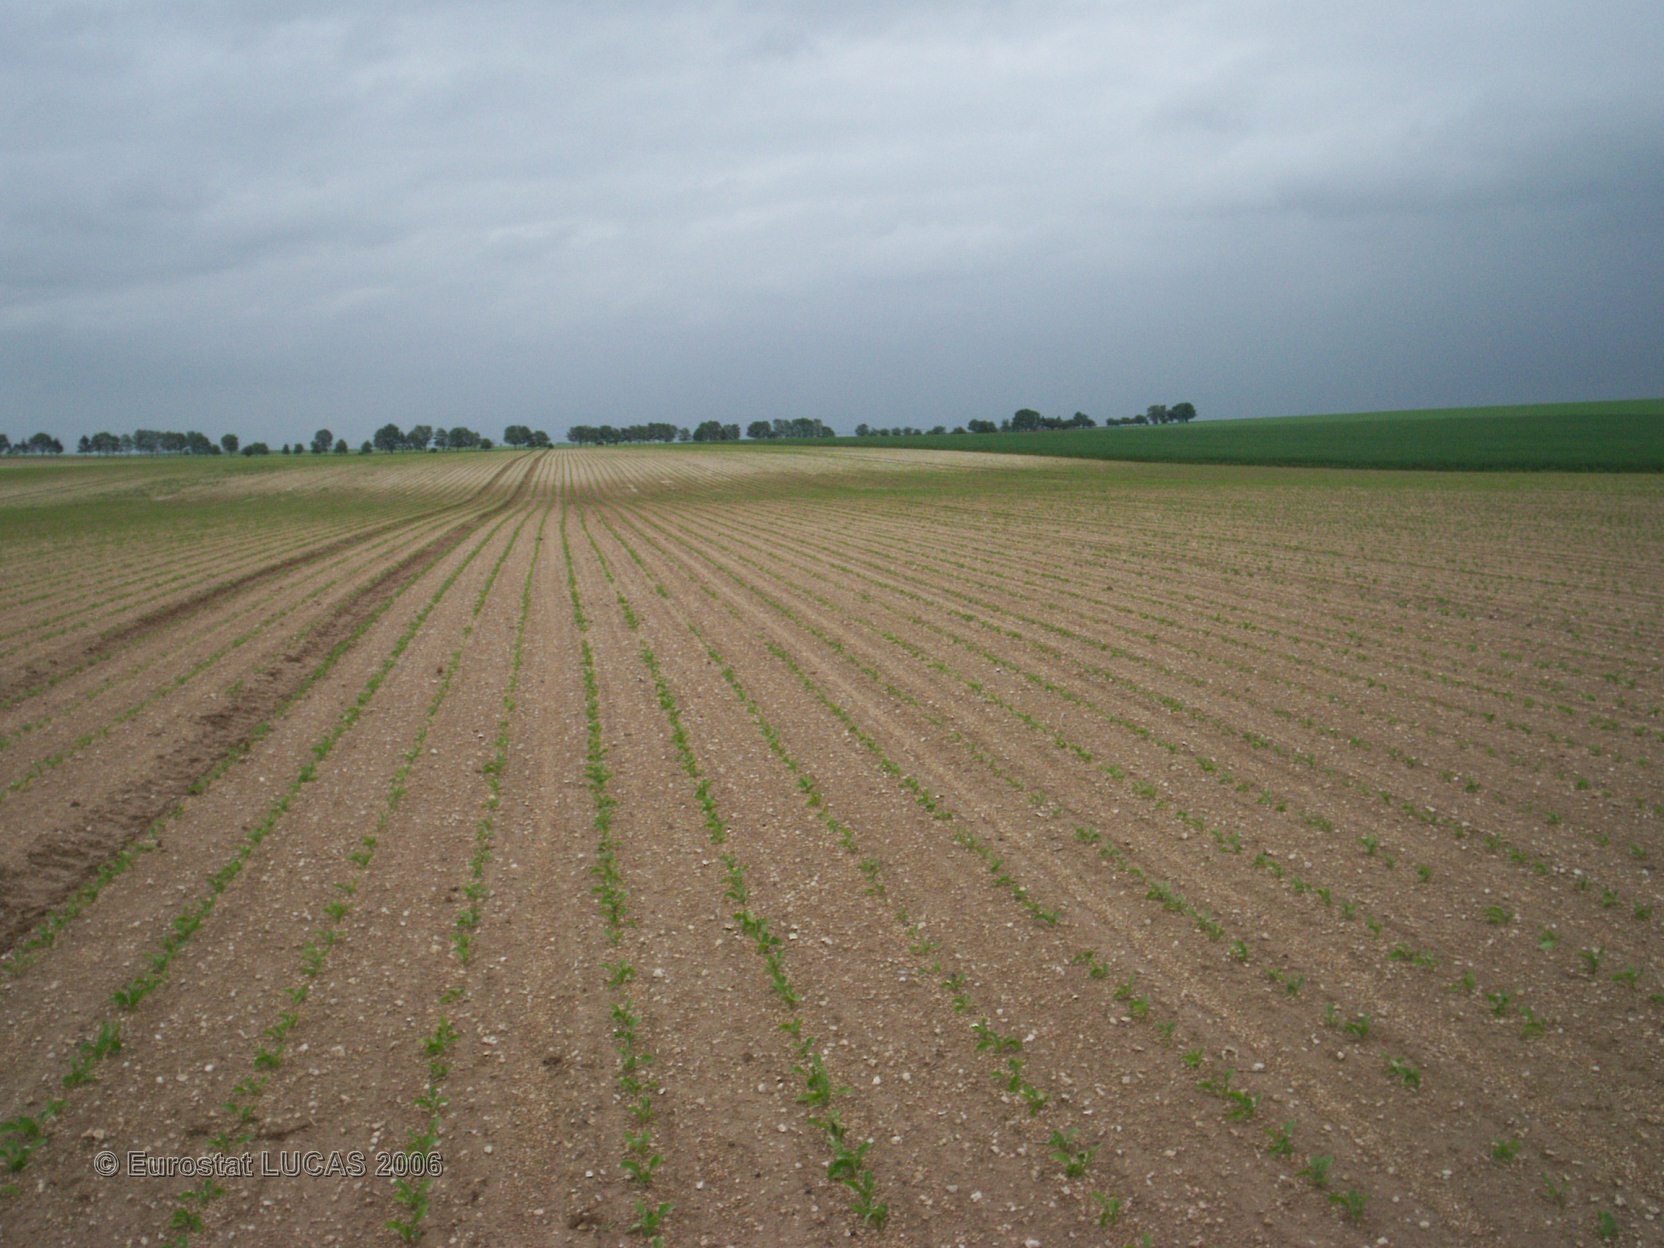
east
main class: Cropland
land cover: Sugar beet
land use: Agriculture (excluding fallow land and kitchen gardens)
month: May
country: FR
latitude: 49.3764
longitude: 4.3351
